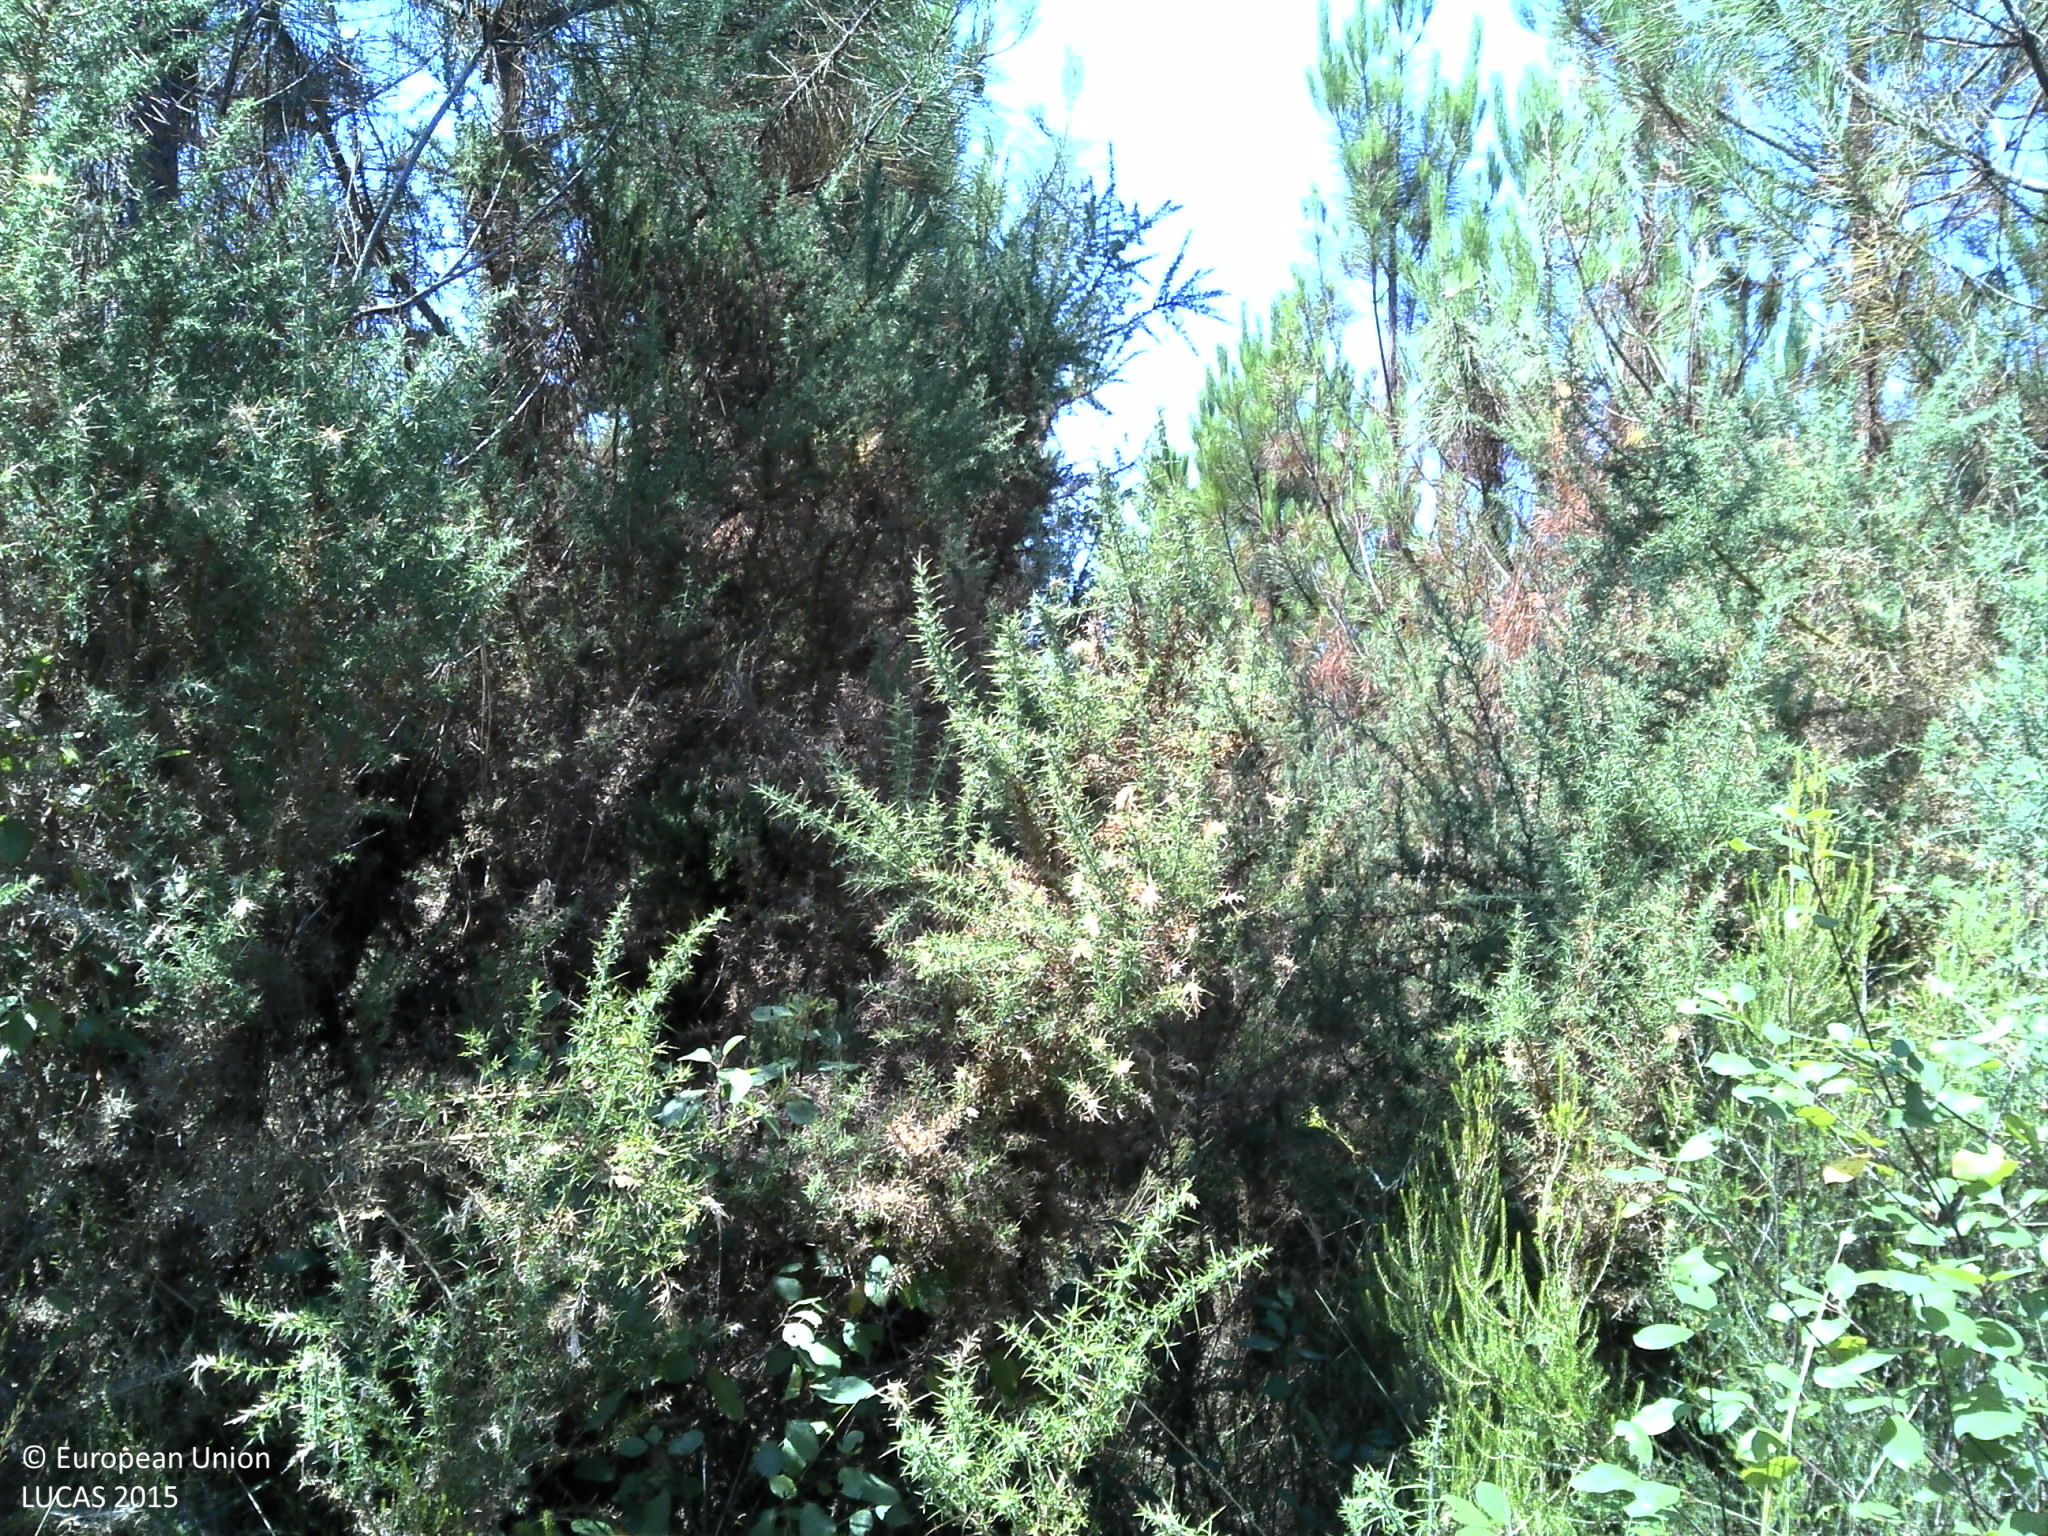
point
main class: Woodland
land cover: Pine dominated coniferous woodland
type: coniferous forest of the mediterranean region
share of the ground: > 75 %
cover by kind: shrubs 60 %, coniferous forest trees 40 %
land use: Forestry
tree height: < 5 m
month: August
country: FR
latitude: 45.0270
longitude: -0.7459
